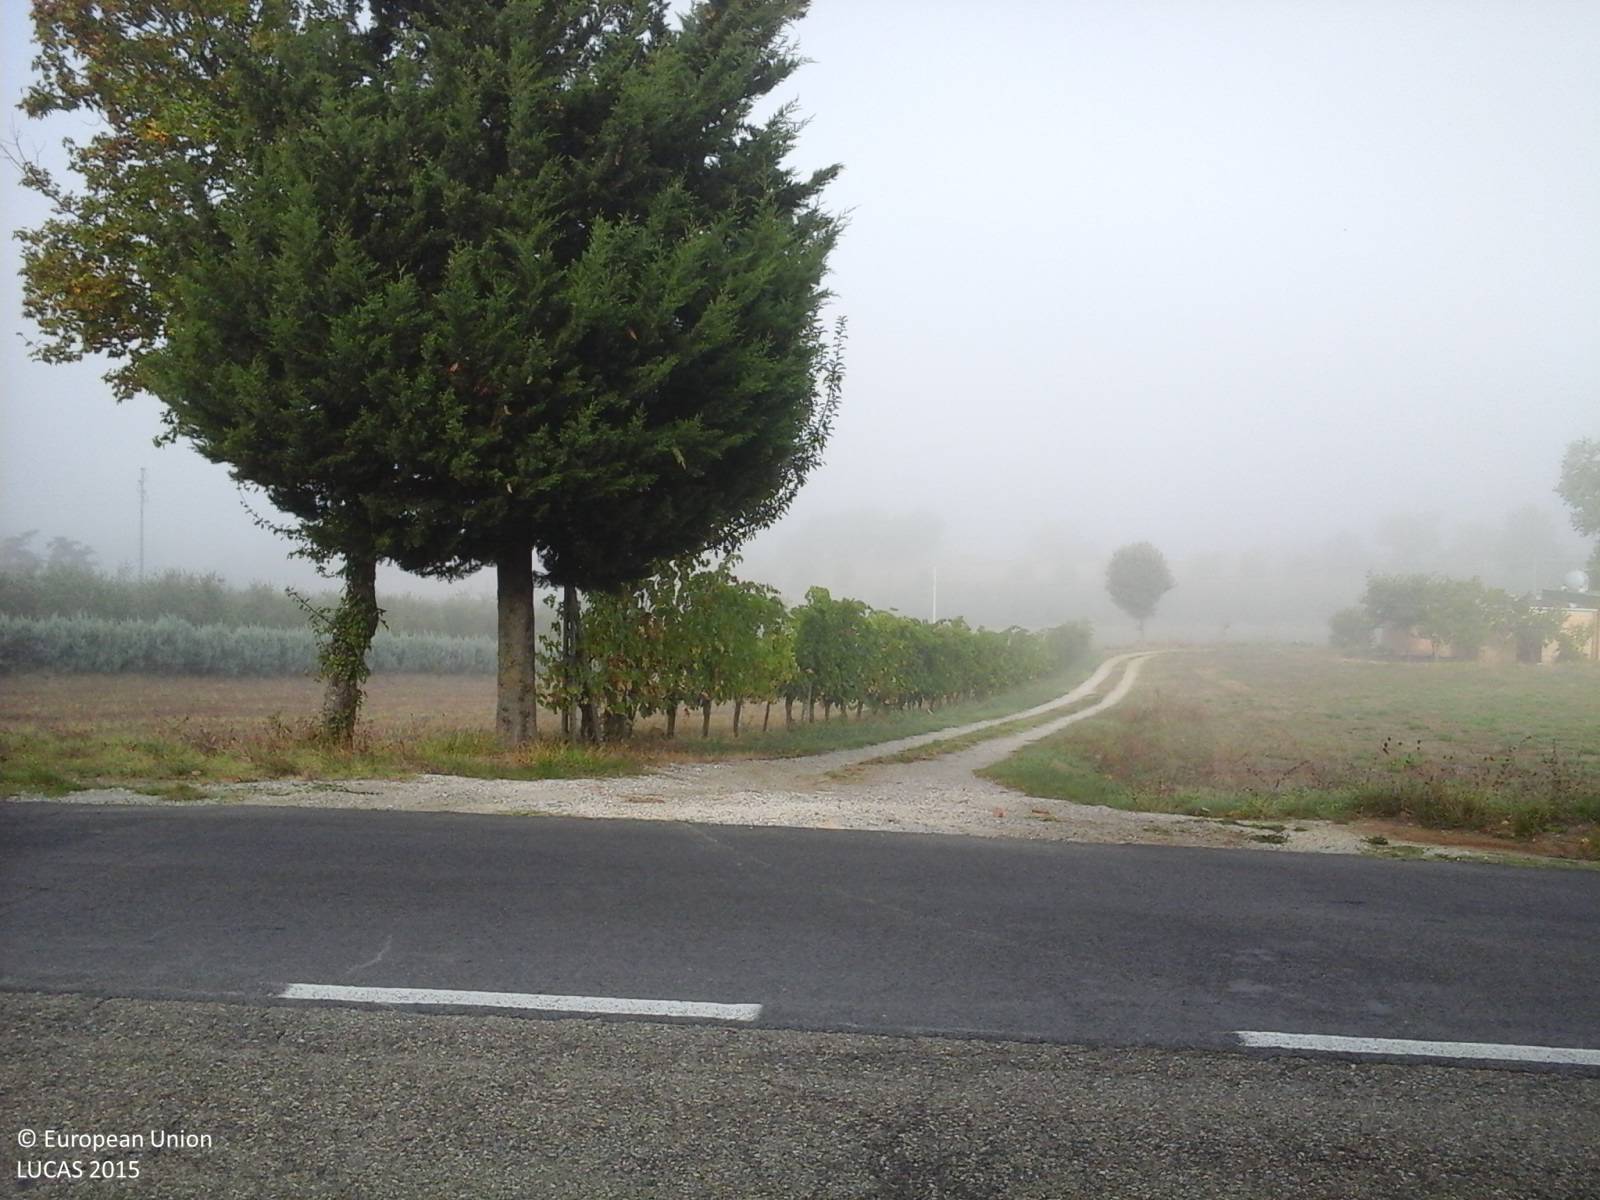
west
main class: Cropland
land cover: Vineyards
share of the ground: 25 - 50 %
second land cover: Grassland without tree/shrub cover
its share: > 75 %
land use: Agriculture (excluding fallow land and kitchen gardens)
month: September
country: IT
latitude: 42.9035
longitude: 12.0879
